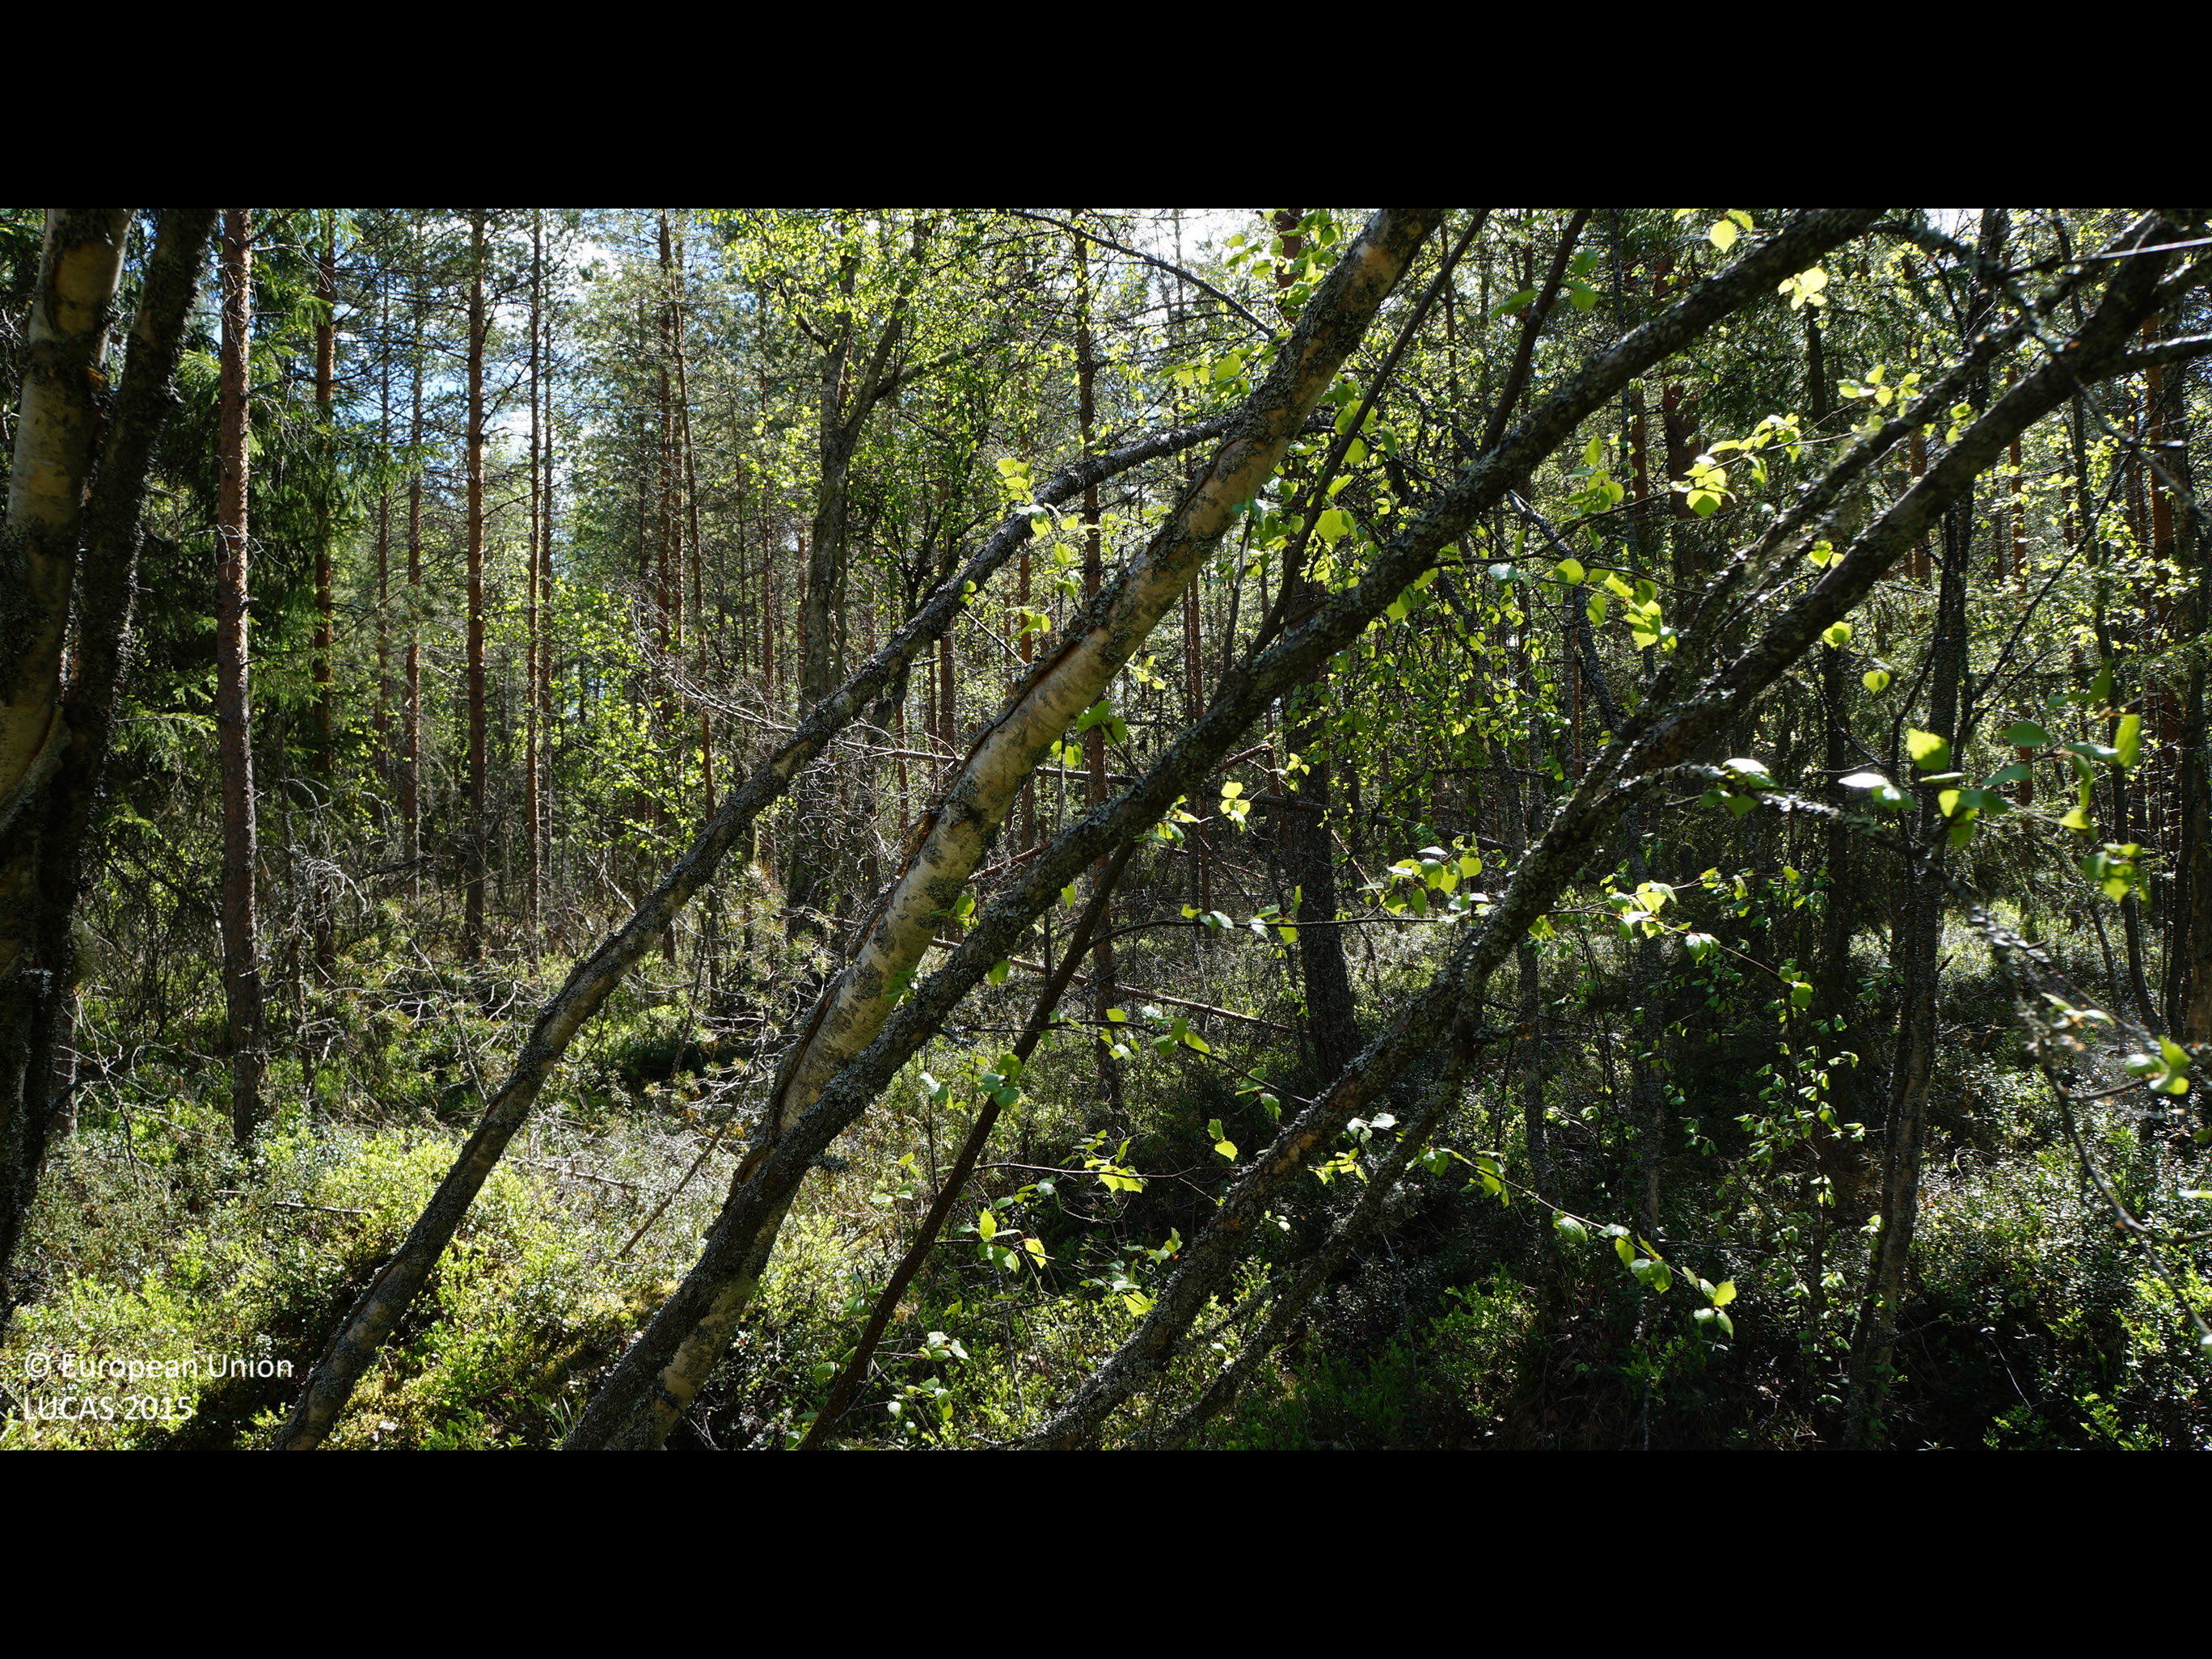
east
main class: Woodland
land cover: Pine dominated mixed woodland
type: boreal forest
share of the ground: > 75 %
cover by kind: coniferous forest trees 65 %, broadleaved forest trees 25 %, shrubs 10 %
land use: Forestry
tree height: > 5 m
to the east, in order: Pine dominated mixed woodland; Other mixed woodland; Ditches and canals; Other mixed woodland; Pine dominated mixed woodland; Pine dominated coniferous woodland; Other mixed woodland; Ditches and canals; Other mixed woodland; Pine dominated coniferous woodland; Spruce dominated coniferous woodland; Other mixed woodland
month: June
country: FI
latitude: 63.7800
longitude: 23.3032
